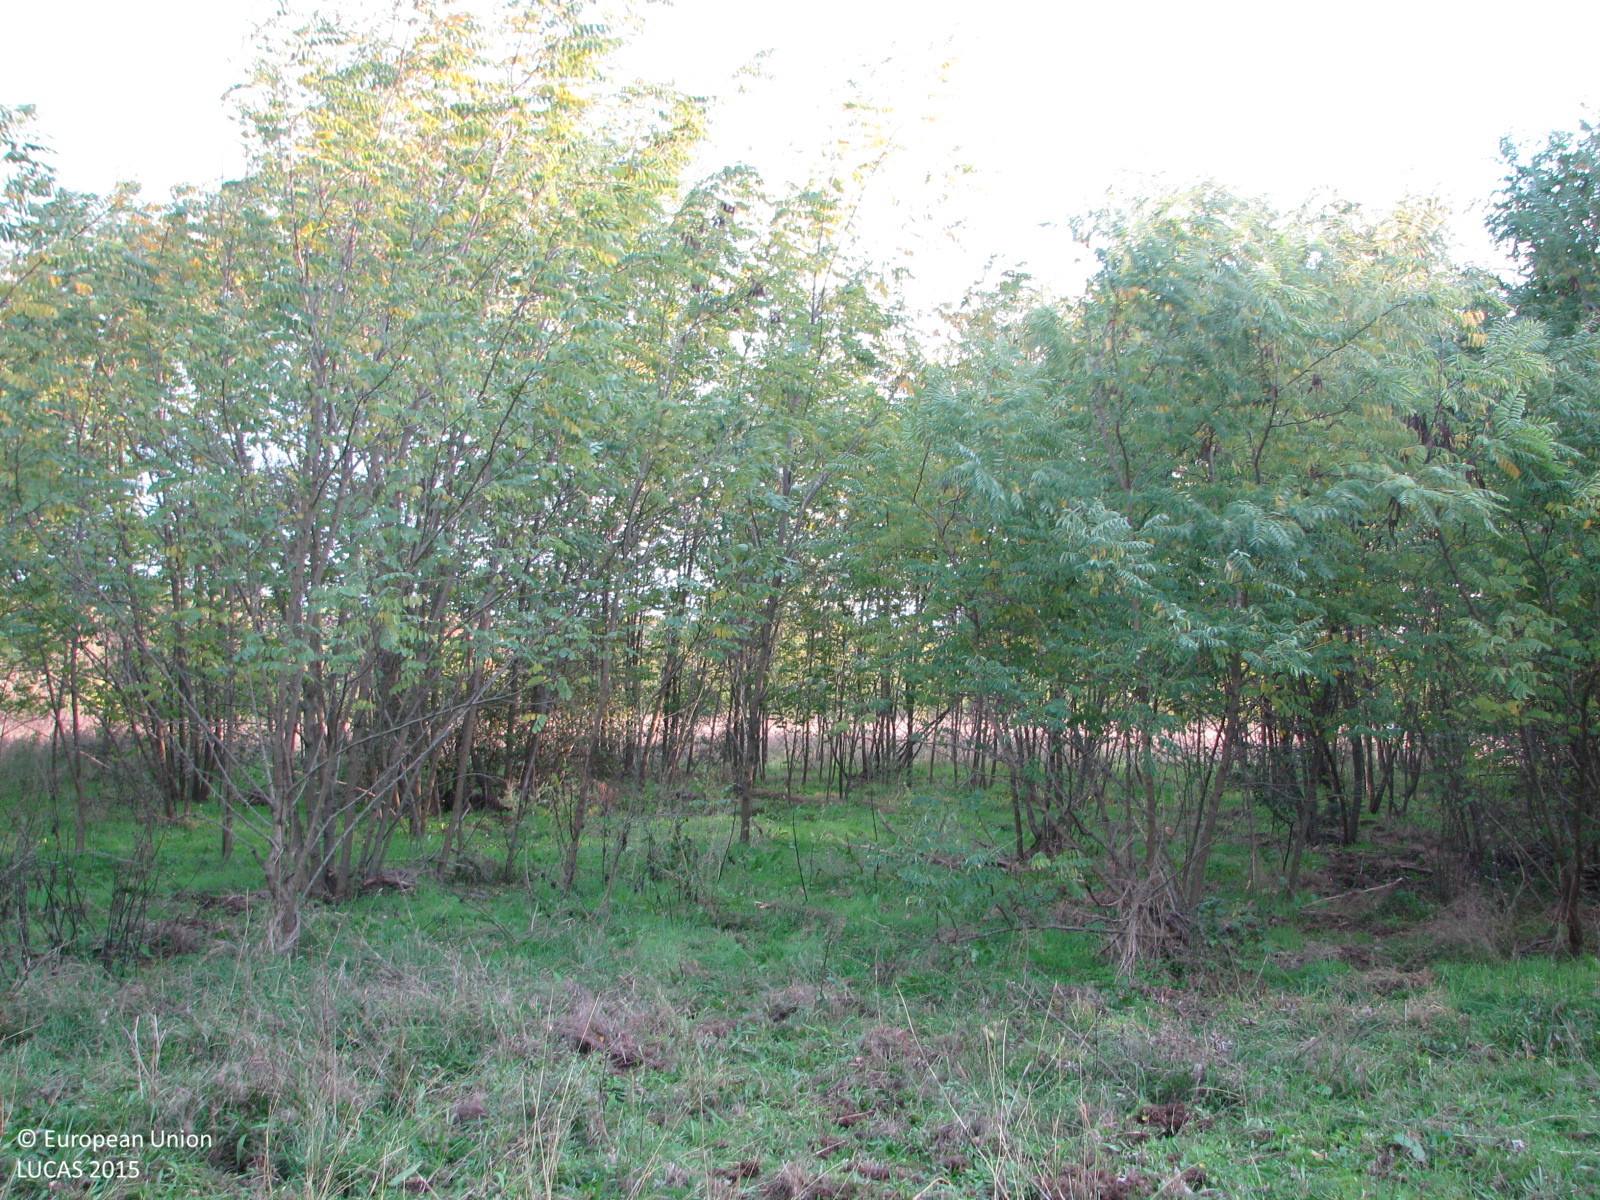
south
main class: Woodland
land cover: Broadleaved woodland
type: thermophilous deciduous forest
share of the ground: 50 - 75 %
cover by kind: broadleaved forest trees 70 %, herbaceous plants 20 %, shrubs 10 %
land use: Semi-natural and natural areas not in use
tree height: < 5 m
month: October
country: BG
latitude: 42.2440
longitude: 26.7342
